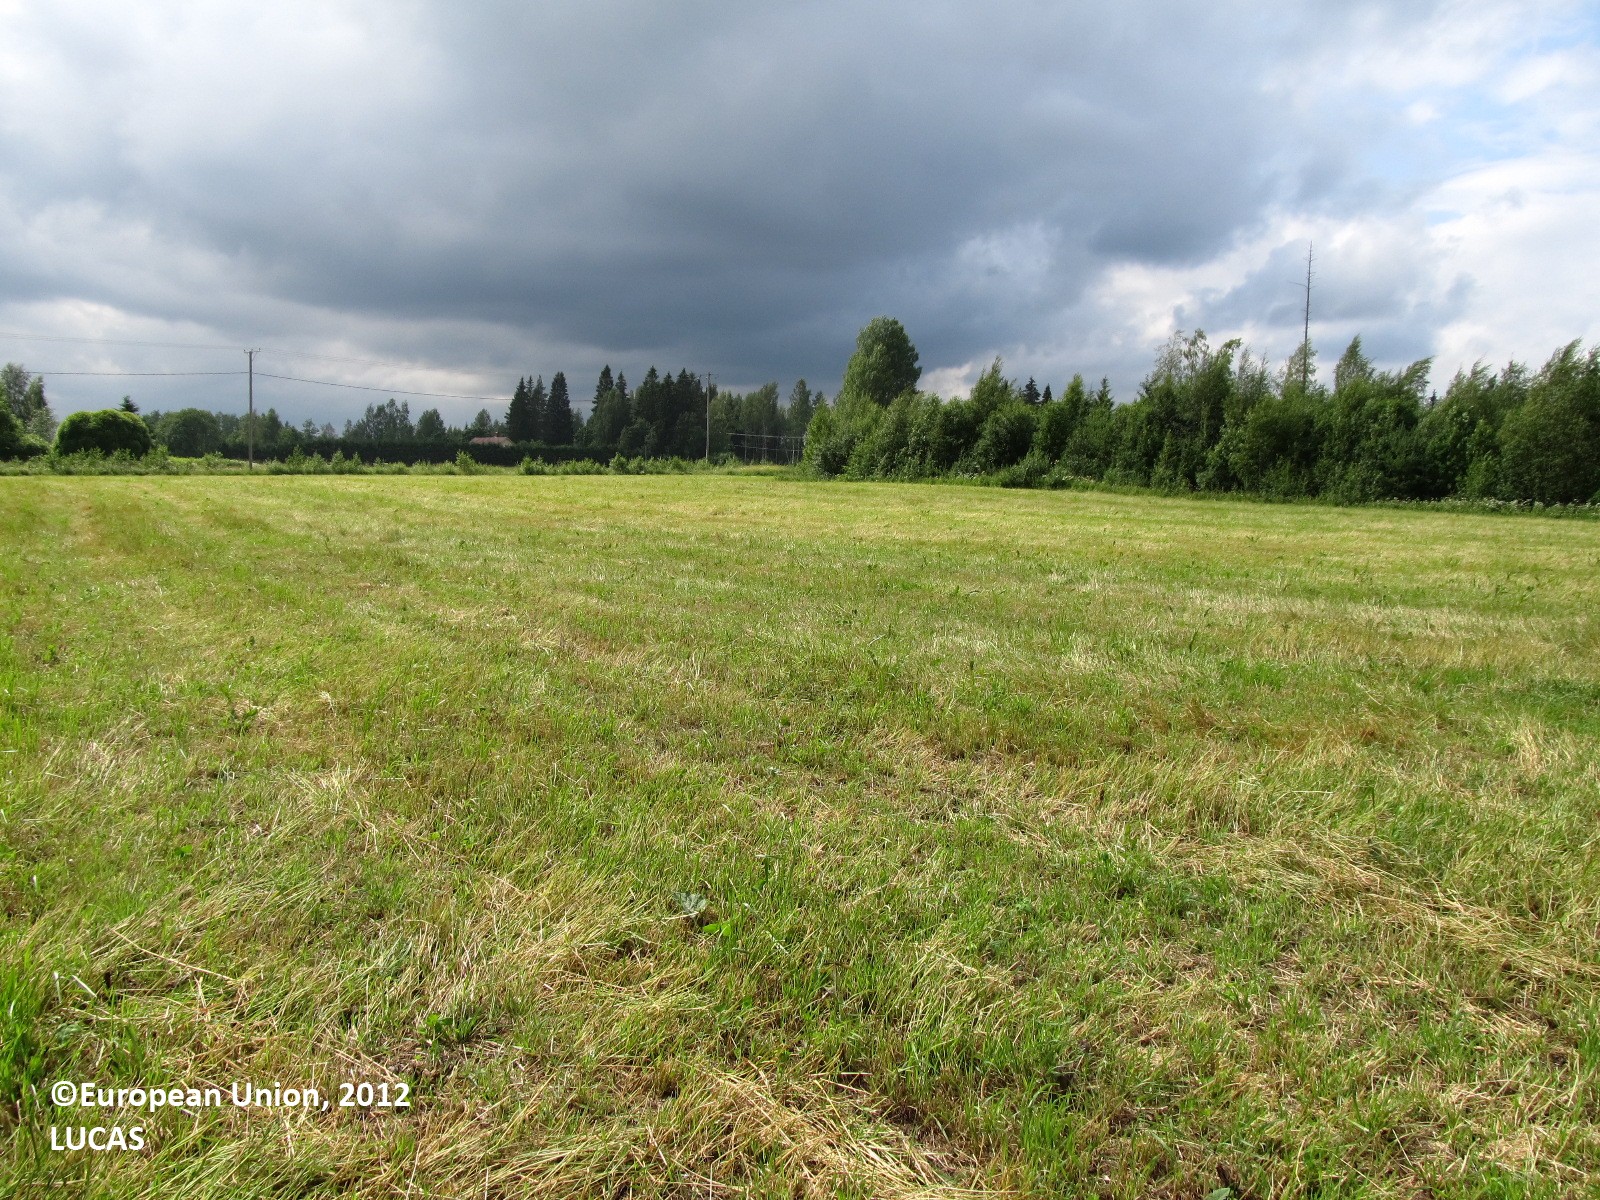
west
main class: Grassland
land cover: Grassland without tree/shrub cover
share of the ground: 50 - 75 %
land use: Fallow land
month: July
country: FI
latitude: 61.9196
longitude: 28.3113
